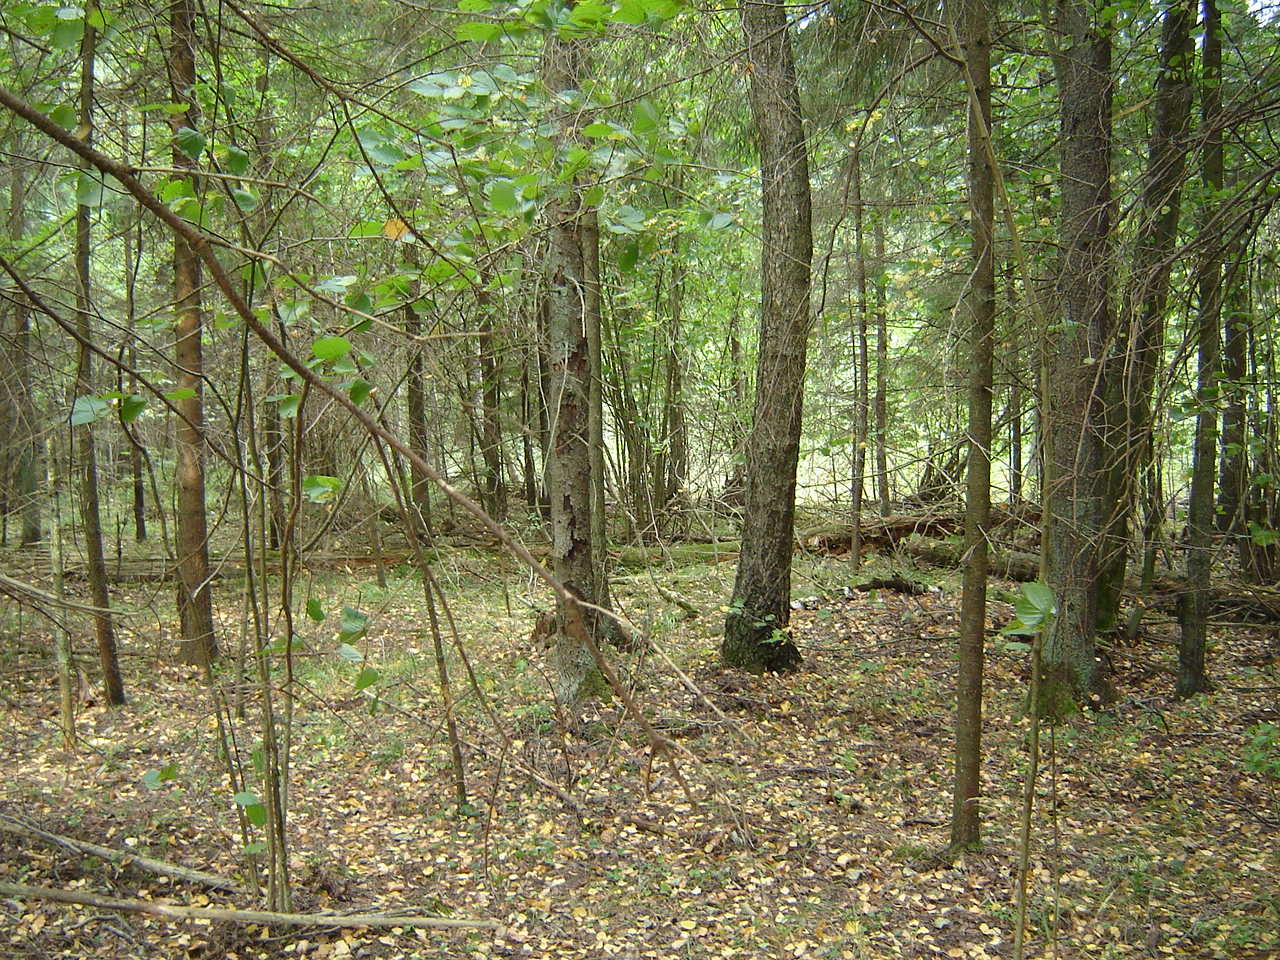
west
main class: Woodland
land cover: Pine dominated mixed woodland
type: hemiboreal forest and nemoral coniferous forest and mixed broadleaved-coniferous forest
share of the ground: > 75 %
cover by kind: coniferous forest trees 60 %, broadleaved forest trees 30 %, herbaceous plants 5 %, unconsolidated bare surface 5 %
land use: Forestry
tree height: > 5 m
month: September
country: LT
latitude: 54.4836
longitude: 25.0733
